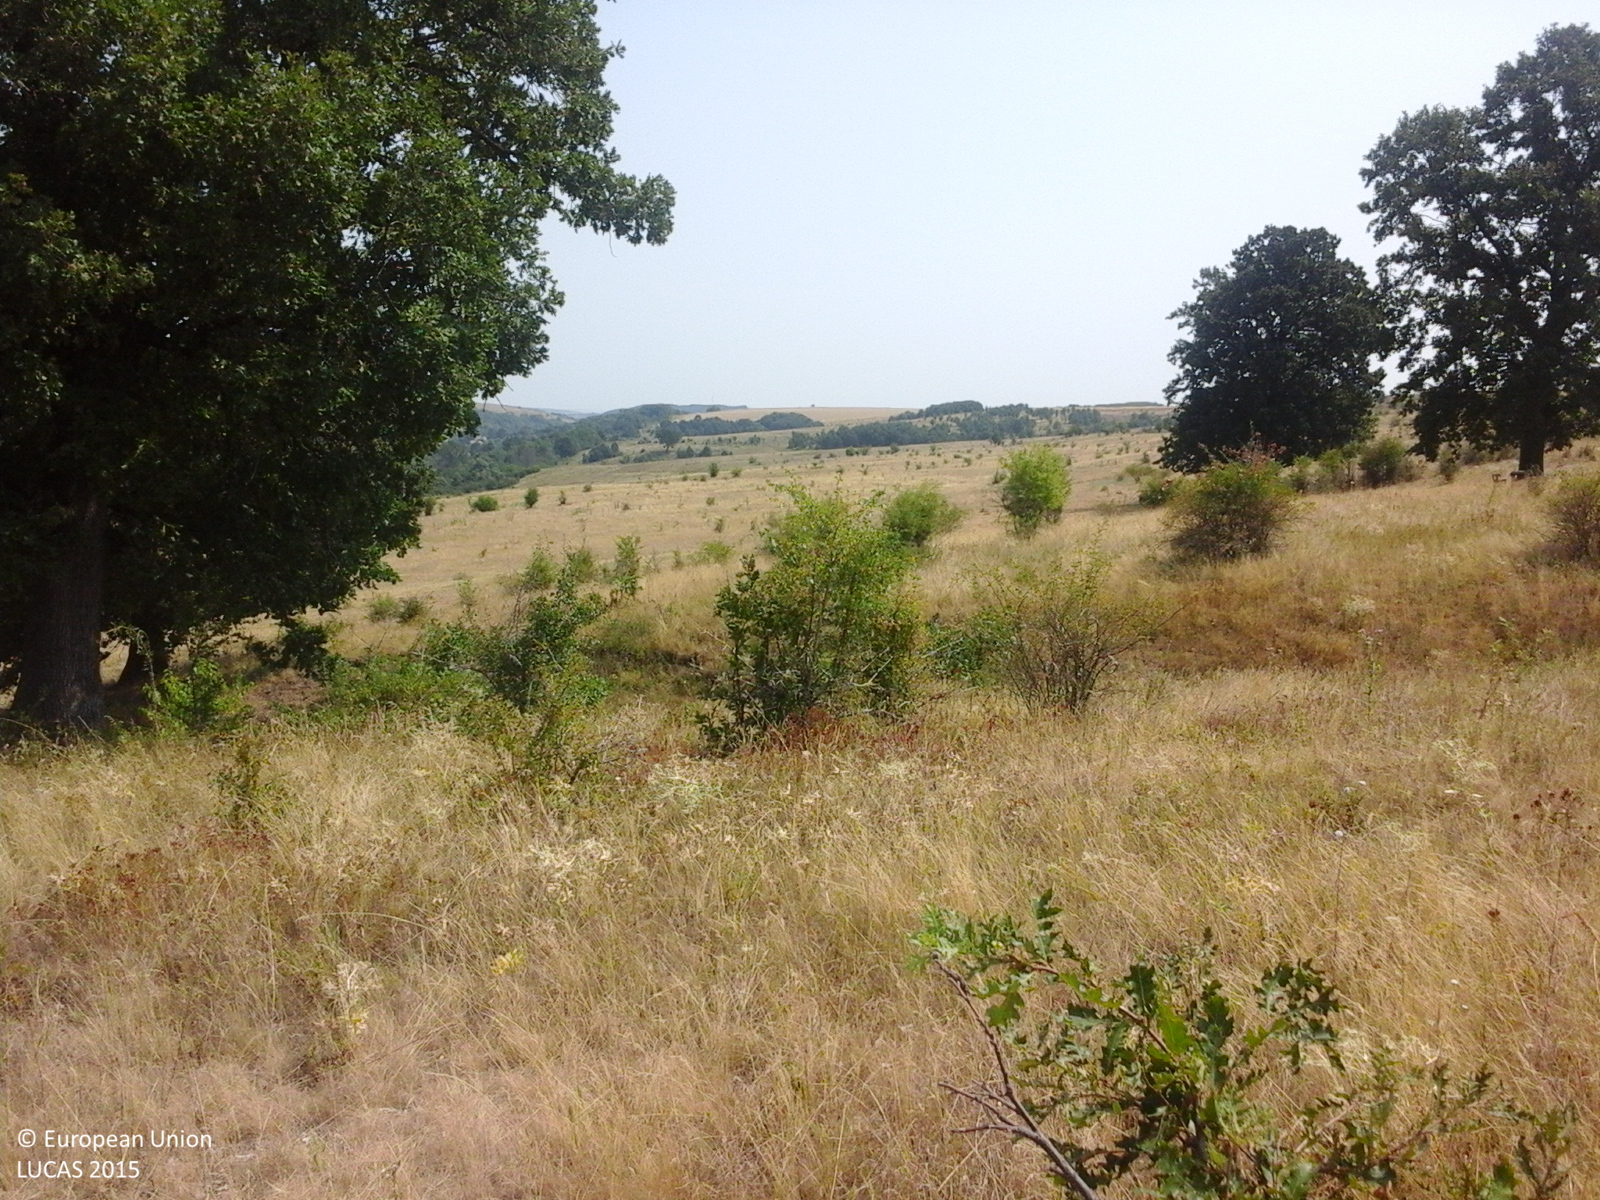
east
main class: Grassland
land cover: Grassland with sparse tree/shrub cover
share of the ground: > 75 %
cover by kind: herbaceous plants 95 %, broadleaved forest trees 5 %
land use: Agriculture (excluding fallow land and kitchen gardens)
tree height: > 5 m
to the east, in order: Grassland with sparse tree/shrub cover; Tracks; Grassland with sparse tree/shrub cover; Tracks; Spontaneously vegetated surfaces
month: August
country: RO
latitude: 44.3617
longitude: 23.3372
